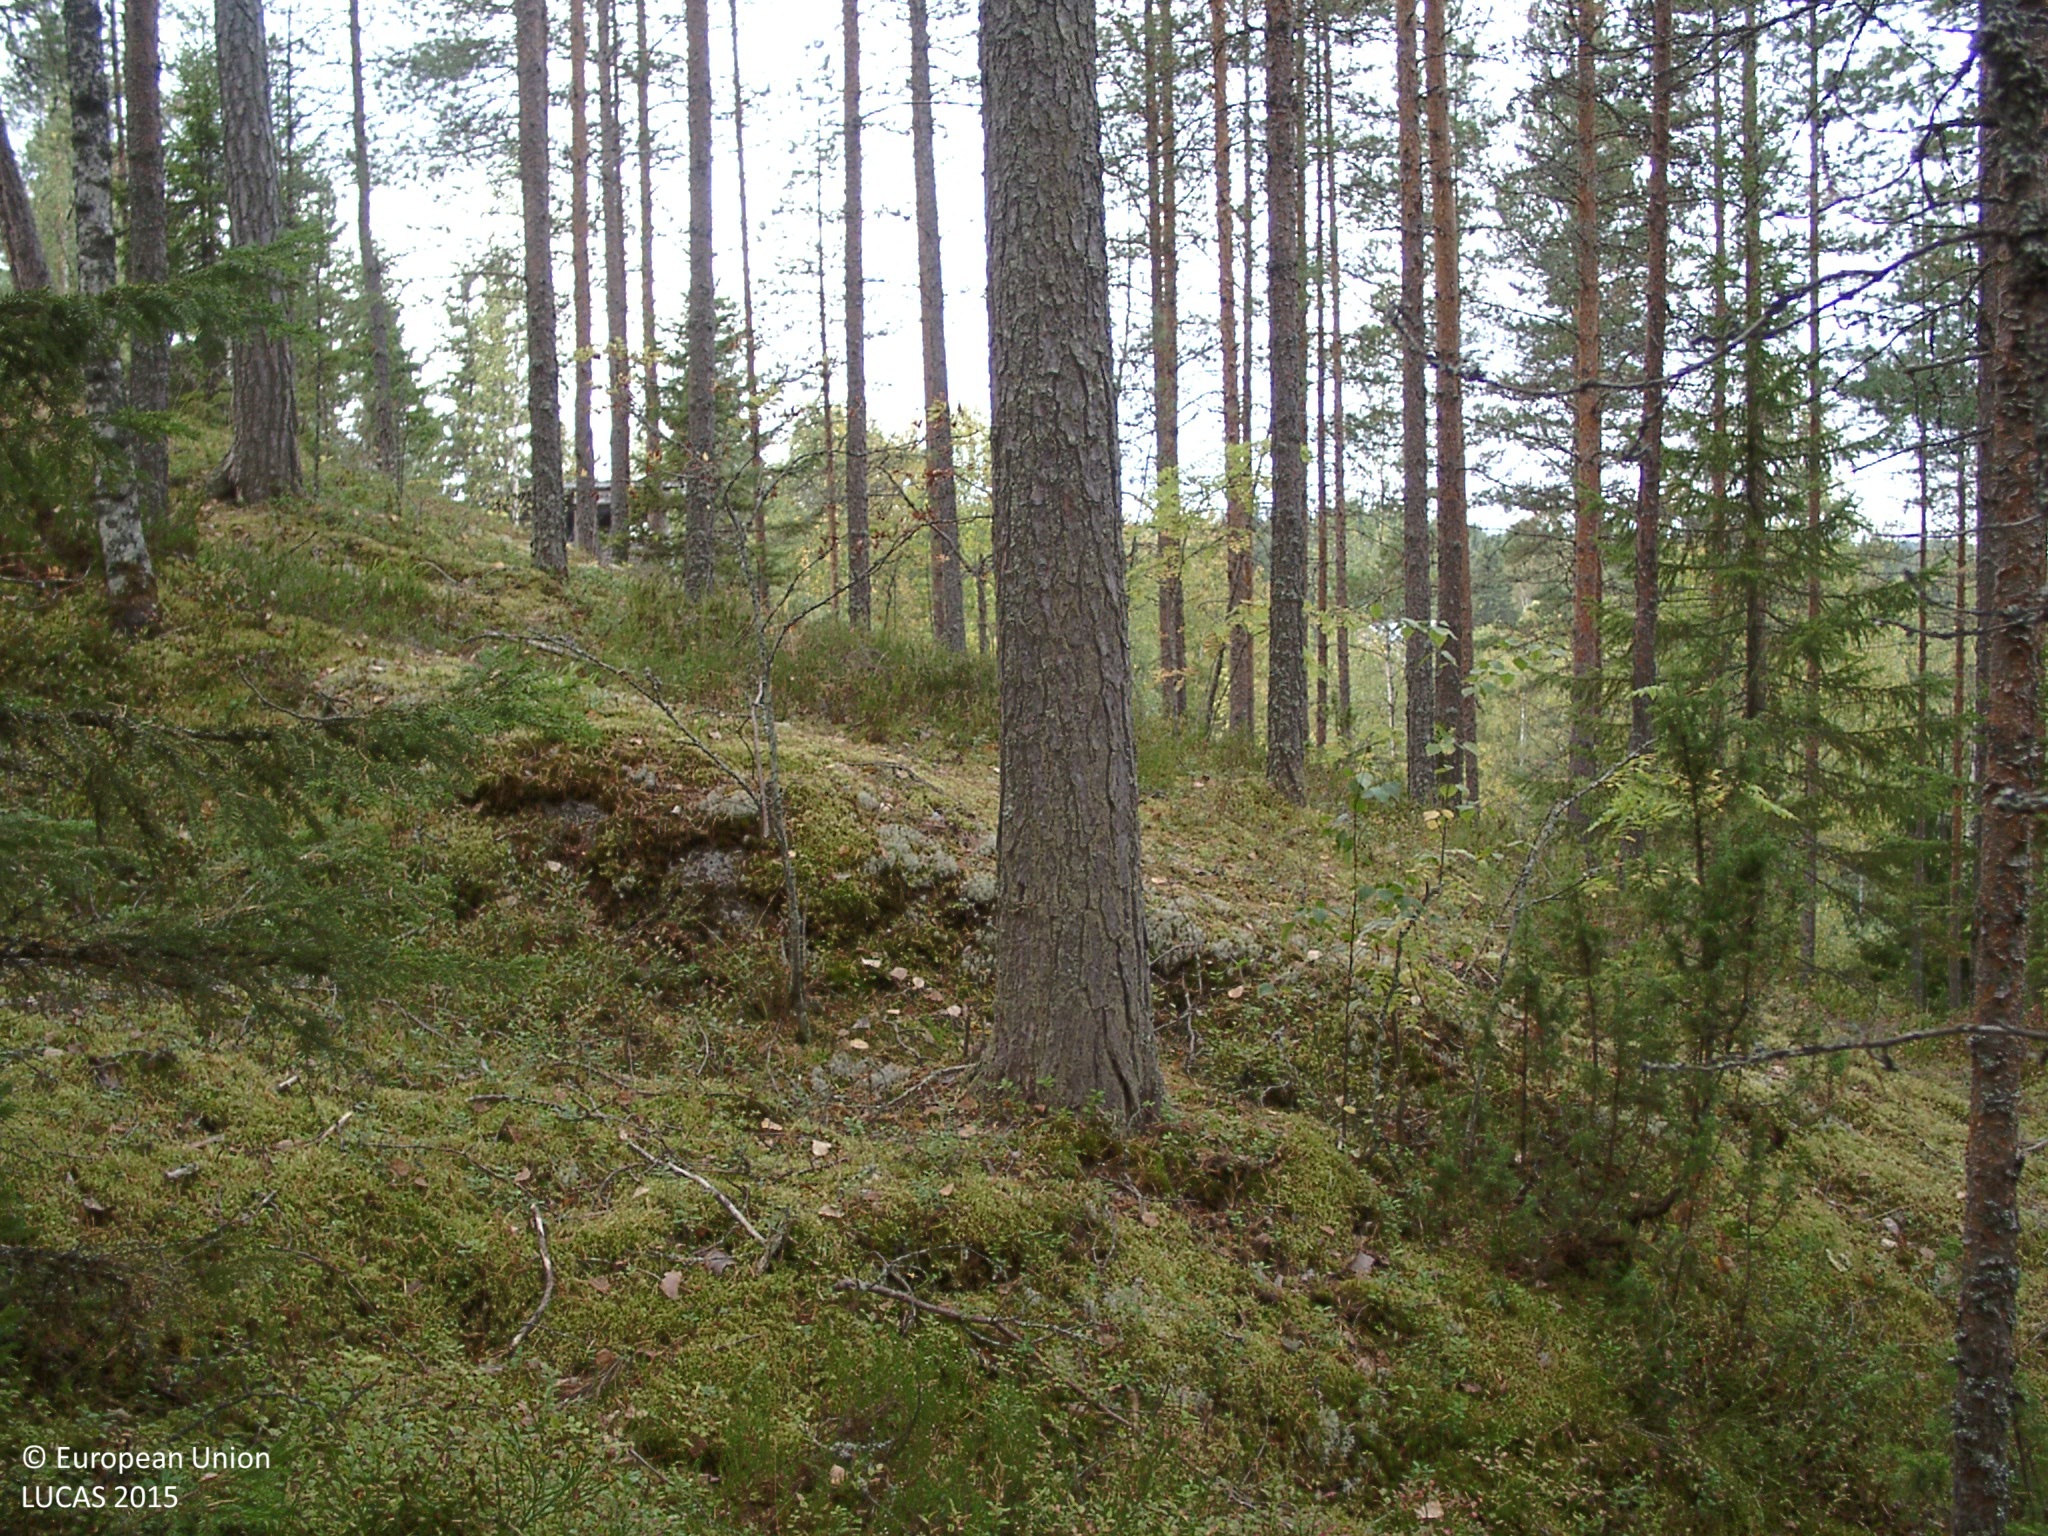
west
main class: Woodland
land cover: Pine dominated coniferous woodland
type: boreal forest
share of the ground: > 75 %
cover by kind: coniferous forest trees 80 %, lichens and mosses 10 %, broadleaved forest trees 5 %, shrubs 5 %
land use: Forestry
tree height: > 5 m
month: September
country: FI
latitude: 62.5581
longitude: 25.8553
